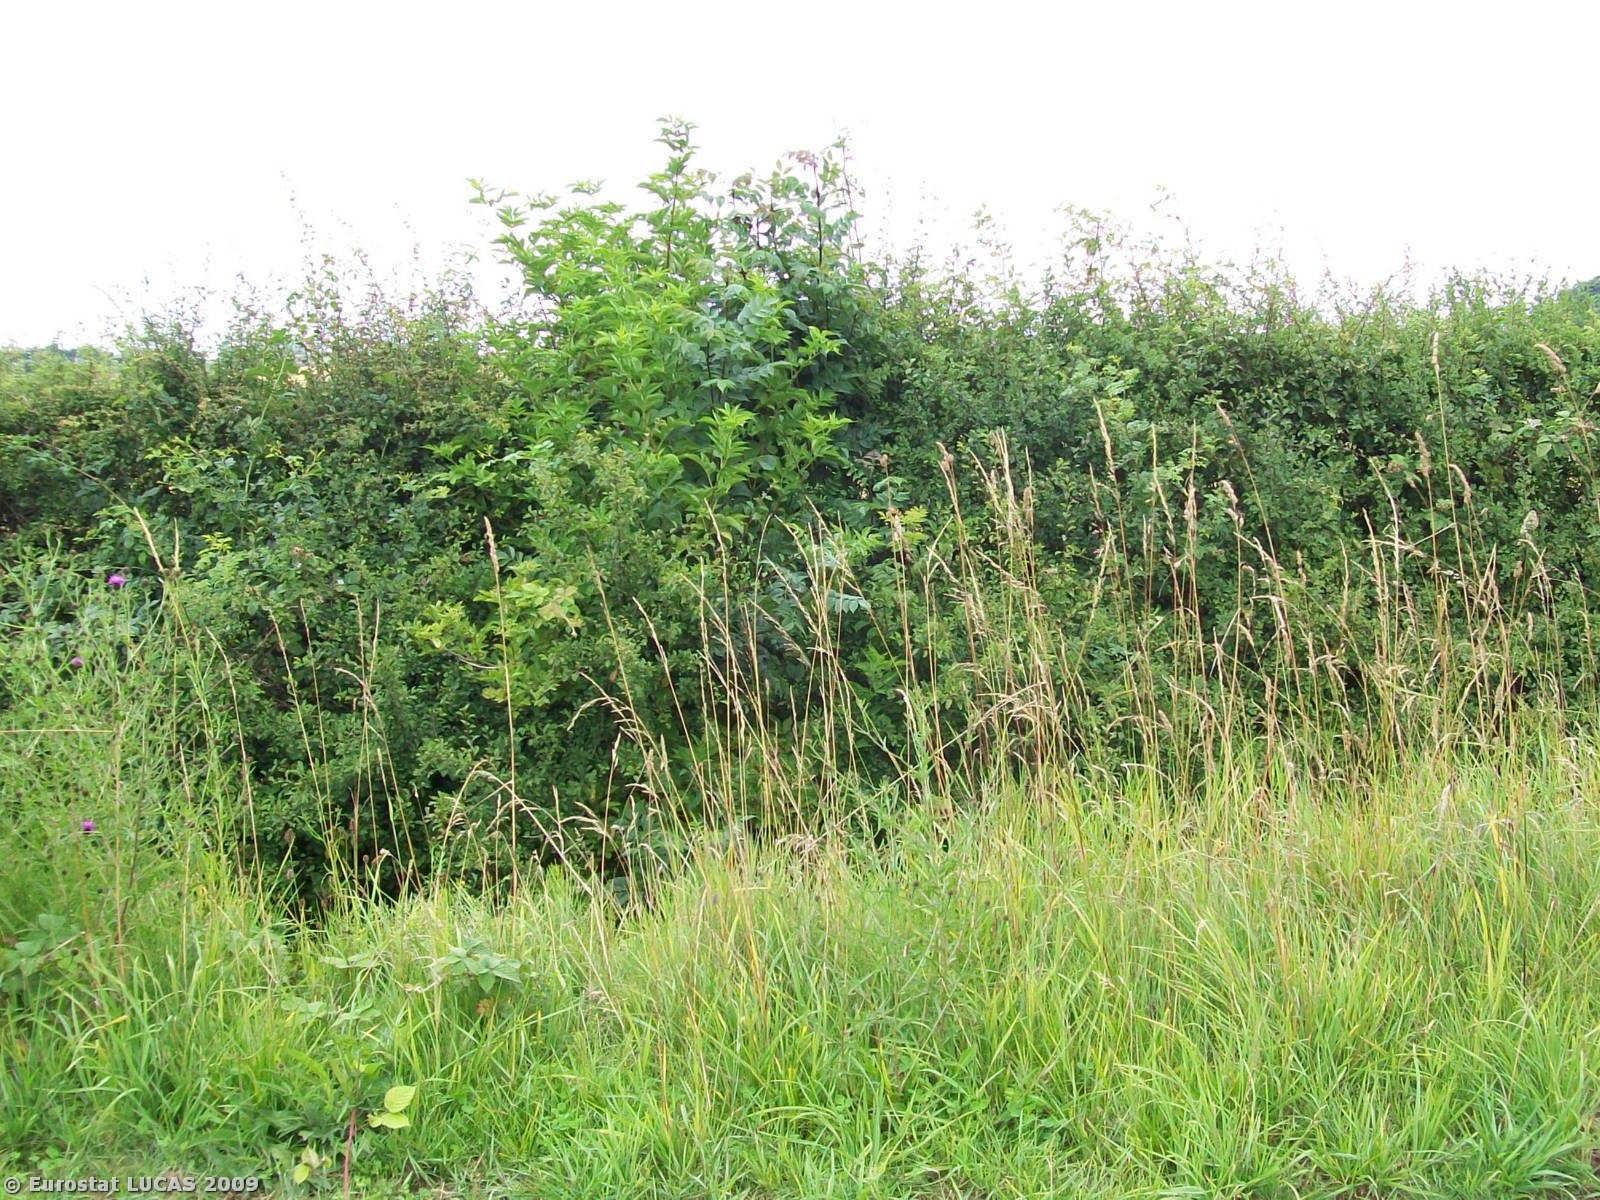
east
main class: Cropland
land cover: Common wheat
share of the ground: > 75 %
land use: Agriculture (excluding fallow land and kitchen gardens)
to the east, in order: Common wheat; Grassland without tree/shrub cover; Ditches and canals; Managed hedges; Grassland without tree/shrub cover; Broadleaved woodland
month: July
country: GB
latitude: 53.8706
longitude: -0.2694
